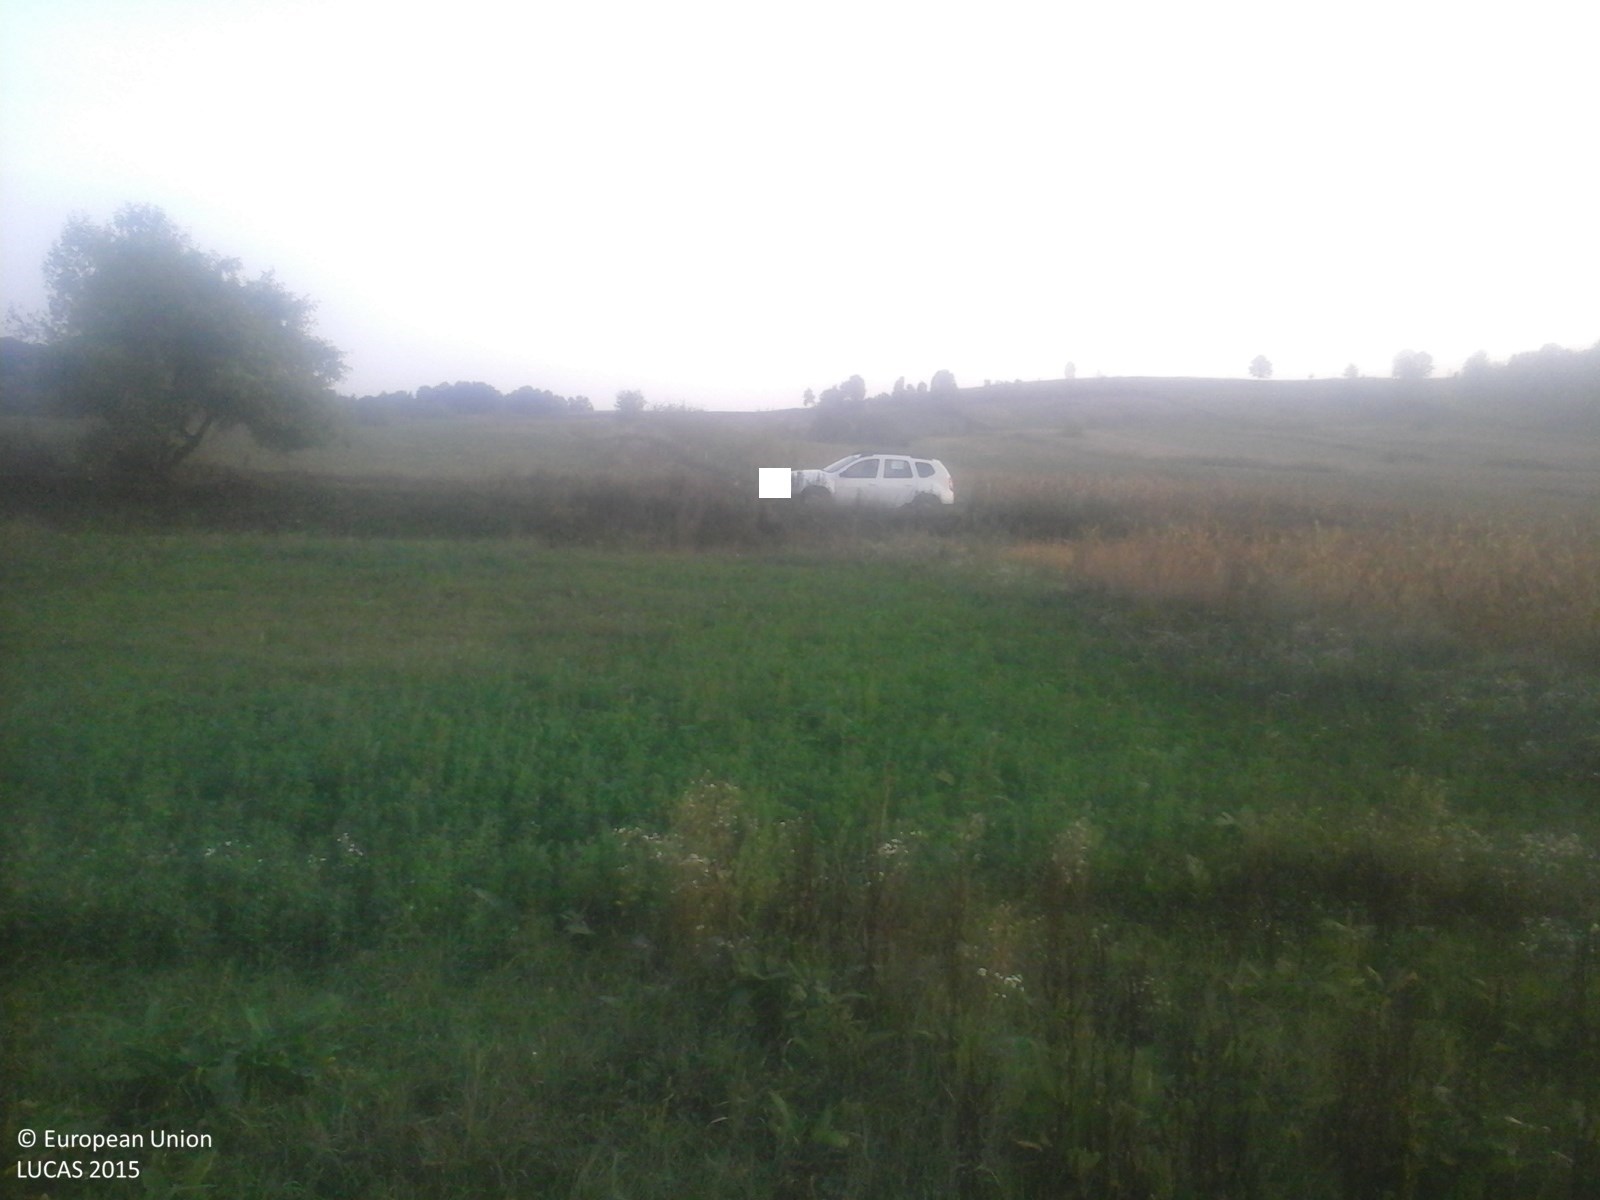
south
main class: Grassland
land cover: Spontaneously vegetated surfaces
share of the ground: > 75 %
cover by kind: herbaceous plants 100 %
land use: Fallow land
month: September
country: RO
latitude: 45.7007
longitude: 22.0750
